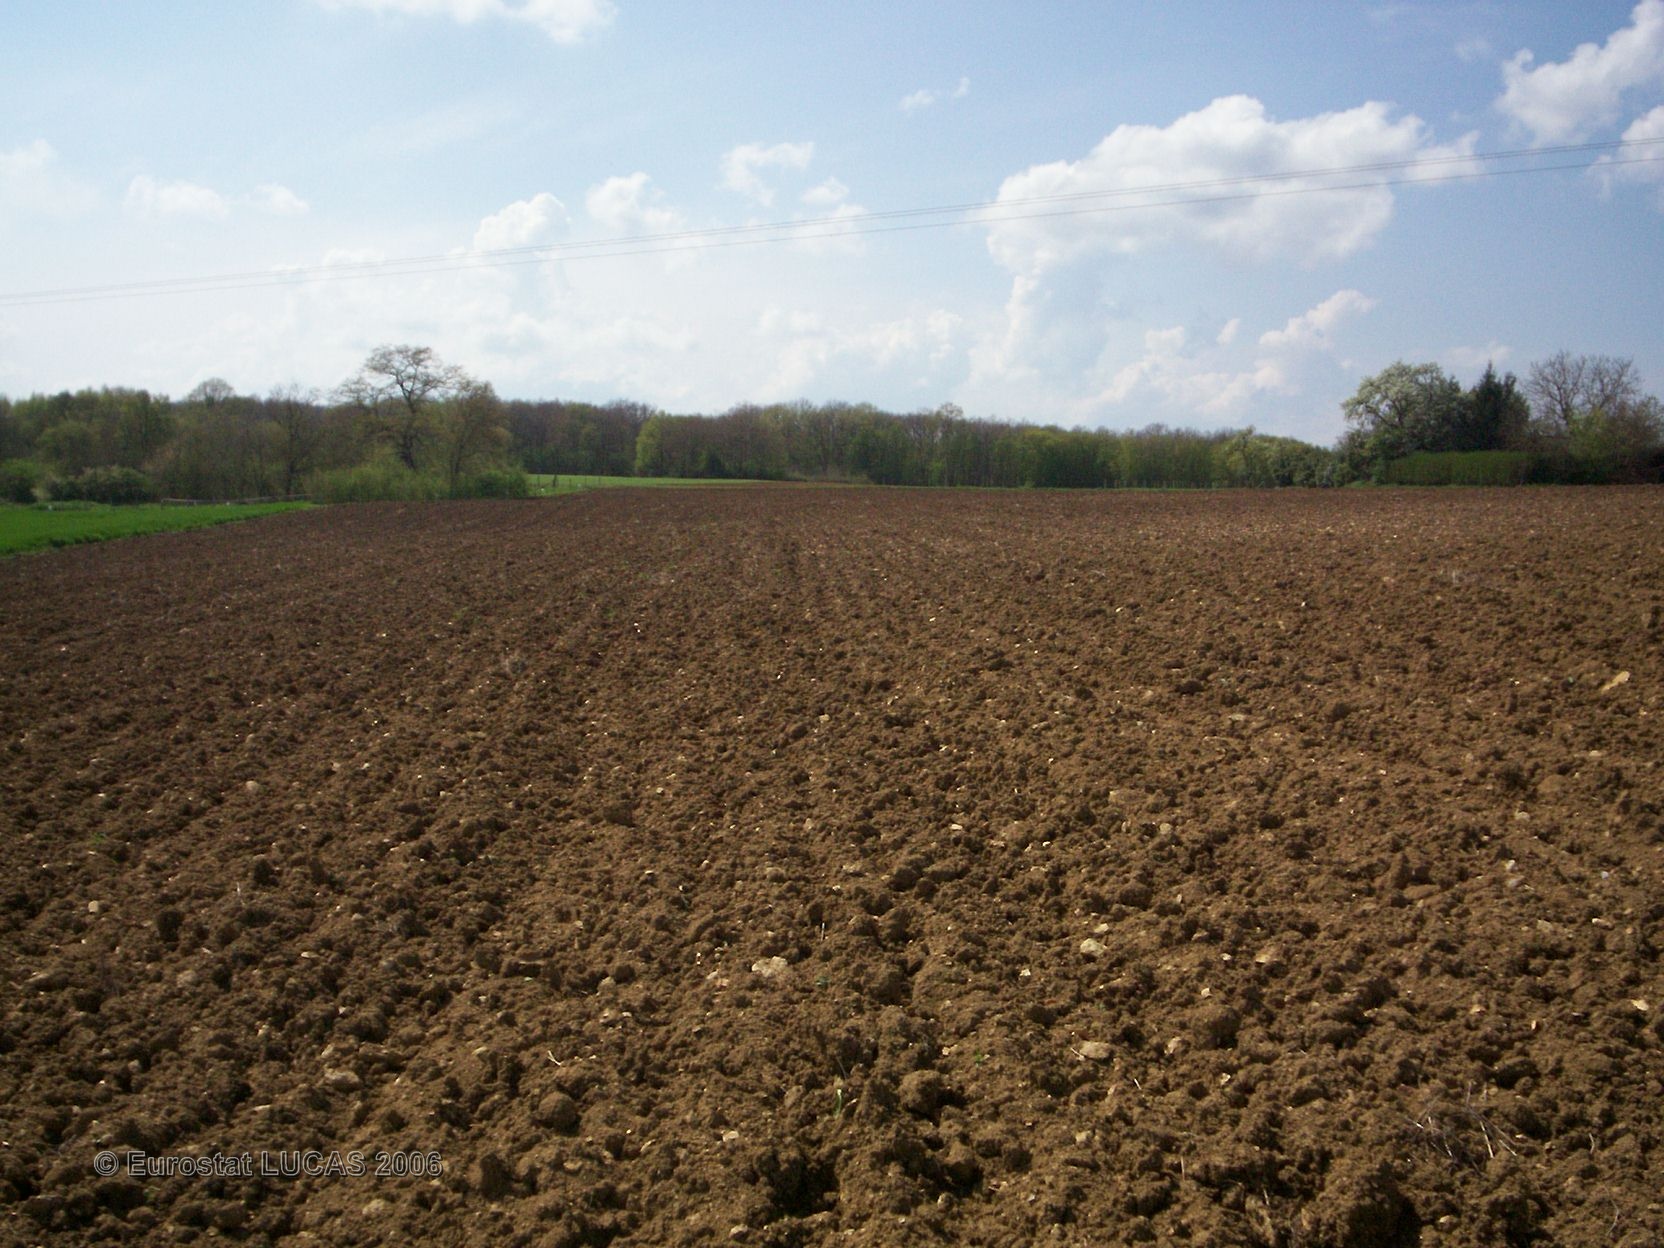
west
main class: Cropland
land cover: Sunflower
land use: Agriculture (excluding fallow land and kitchen gardens)
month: May
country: FR
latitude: 47.3663
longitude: 2.9631
